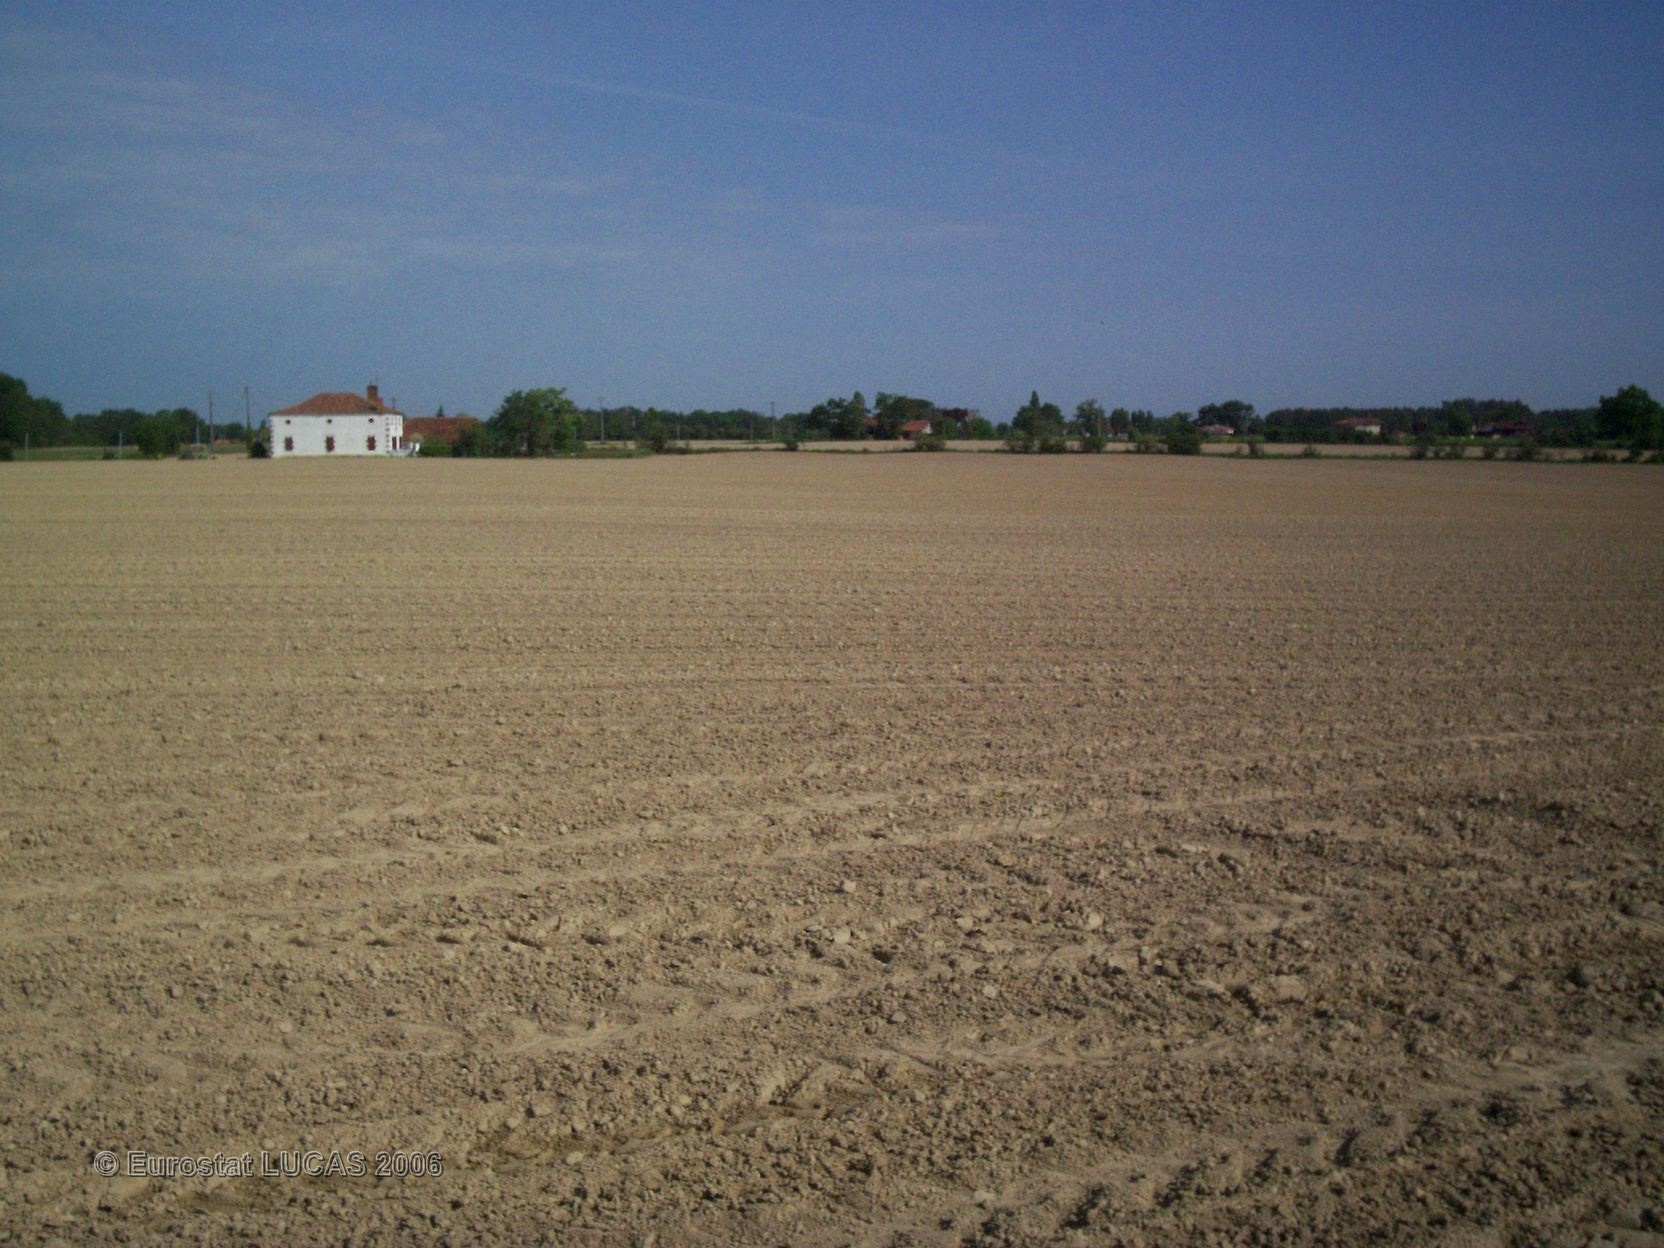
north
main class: Cropland
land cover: Maize
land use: Agriculture (excluding fallow land and kitchen gardens)
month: June
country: FR
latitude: 43.7380
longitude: -0.3775
